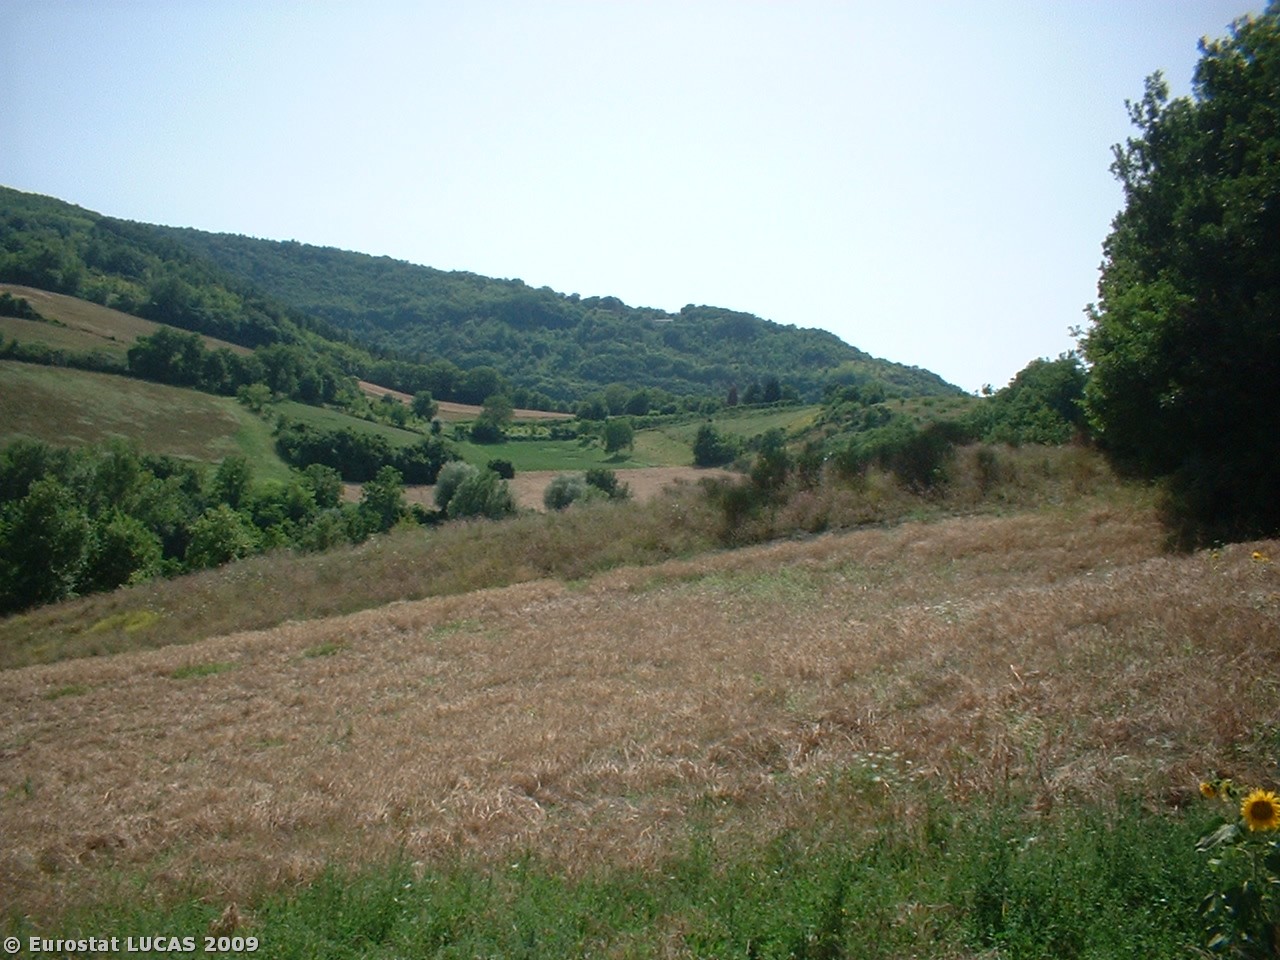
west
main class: Cropland
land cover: Durum wheat
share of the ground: > 75 %
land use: Agriculture (excluding fallow land and kitchen gardens)
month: July
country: IT
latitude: 43.4256
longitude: 12.8953
